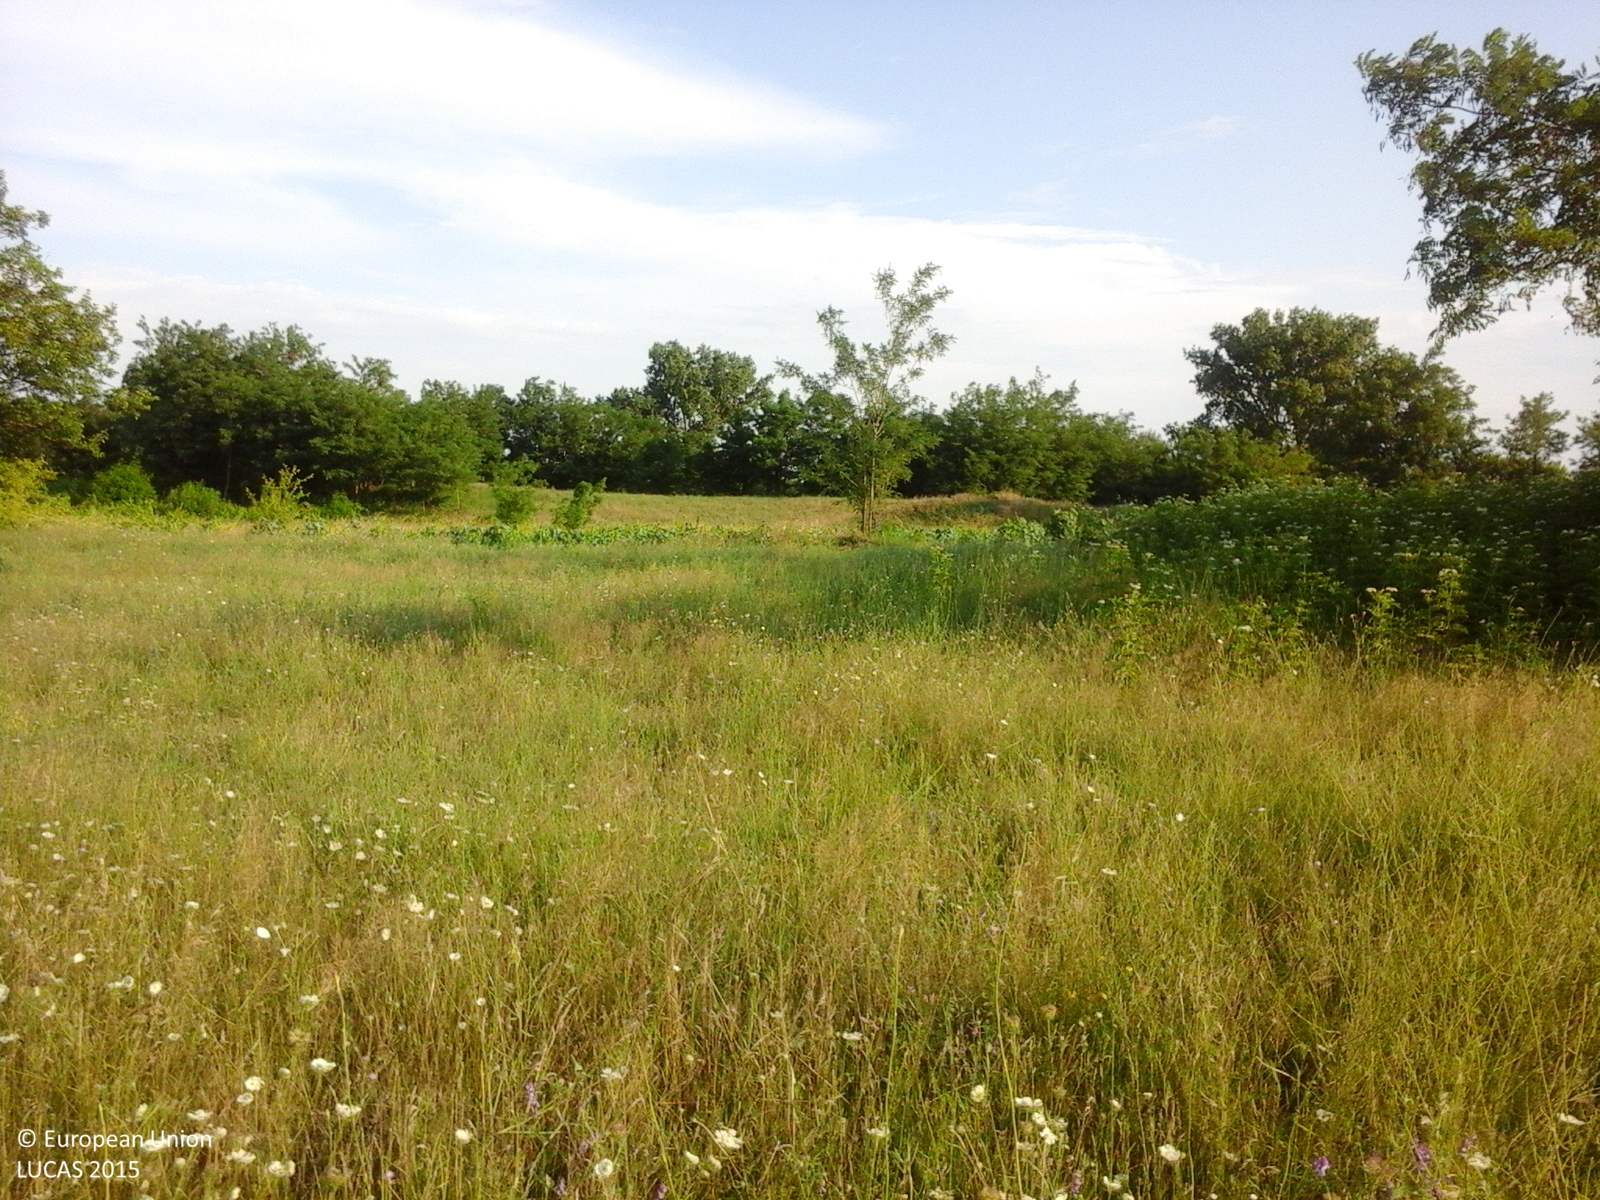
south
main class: Grassland
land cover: Grassland without tree/shrub cover
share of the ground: > 75 %
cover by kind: herbaceous plants 100 %
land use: Agriculture (excluding fallow land and kitchen gardens)
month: July
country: RO
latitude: 43.7729
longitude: 24.1842
